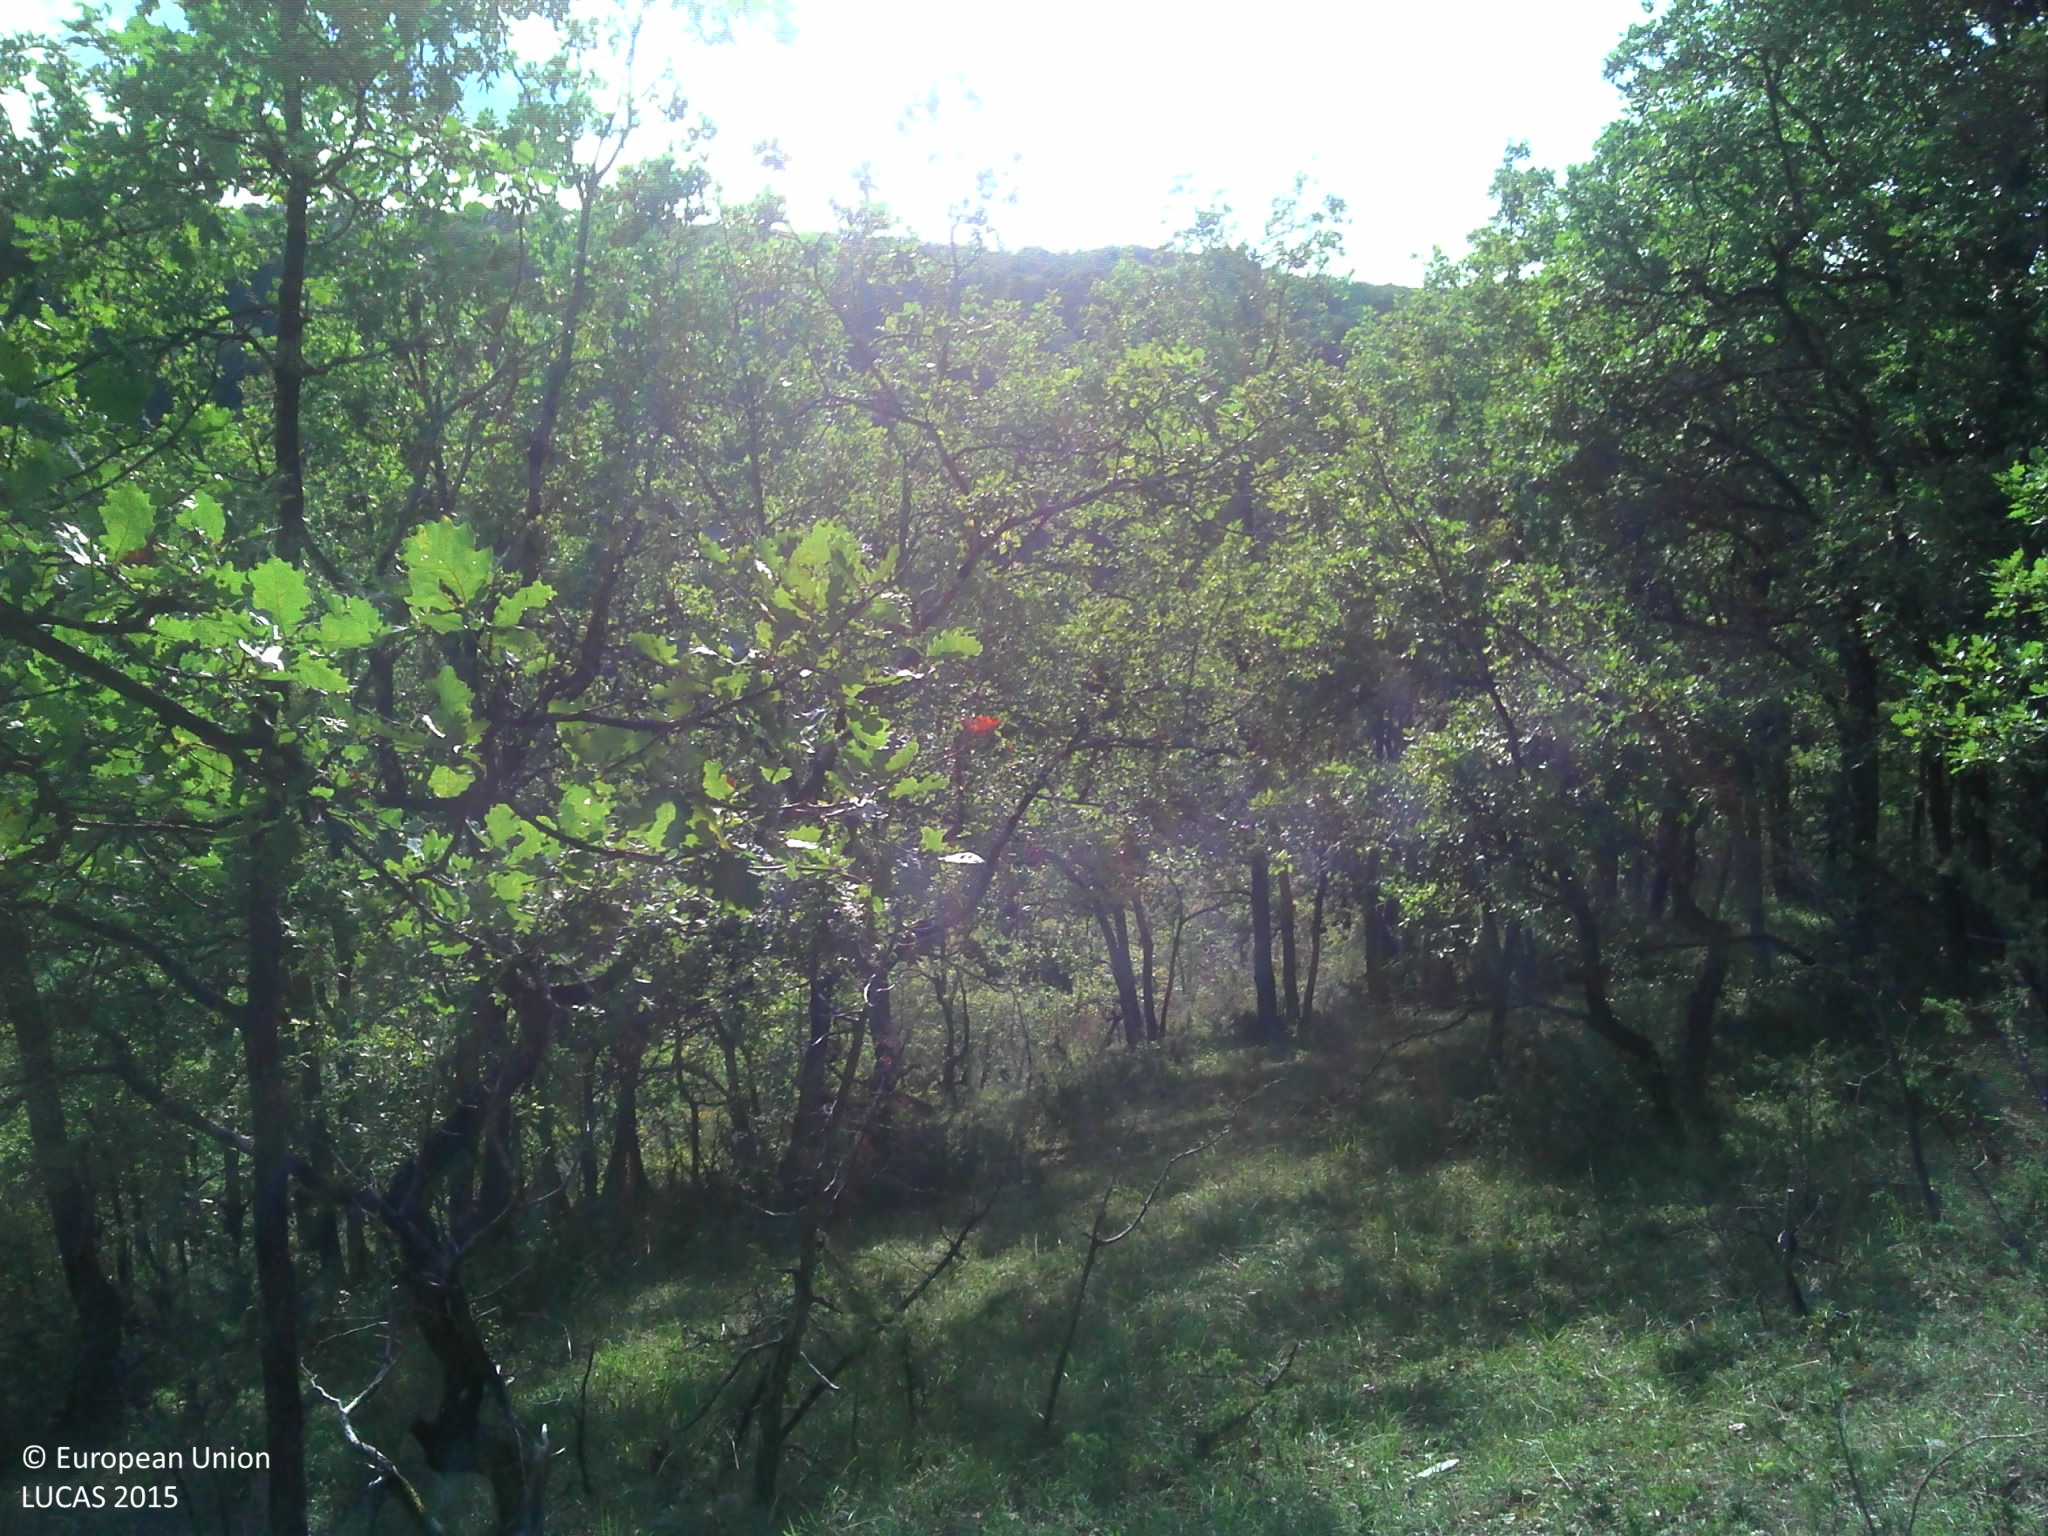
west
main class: Woodland
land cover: Broadleaved woodland
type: thermophilous deciduous forest
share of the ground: > 75 %
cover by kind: broadleaved forest trees 60 %, herbaceous plants 30 %, shrubs 10 %
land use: Forestry
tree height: > 5 m
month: September
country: FR
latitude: 44.6885
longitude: 1.4803
